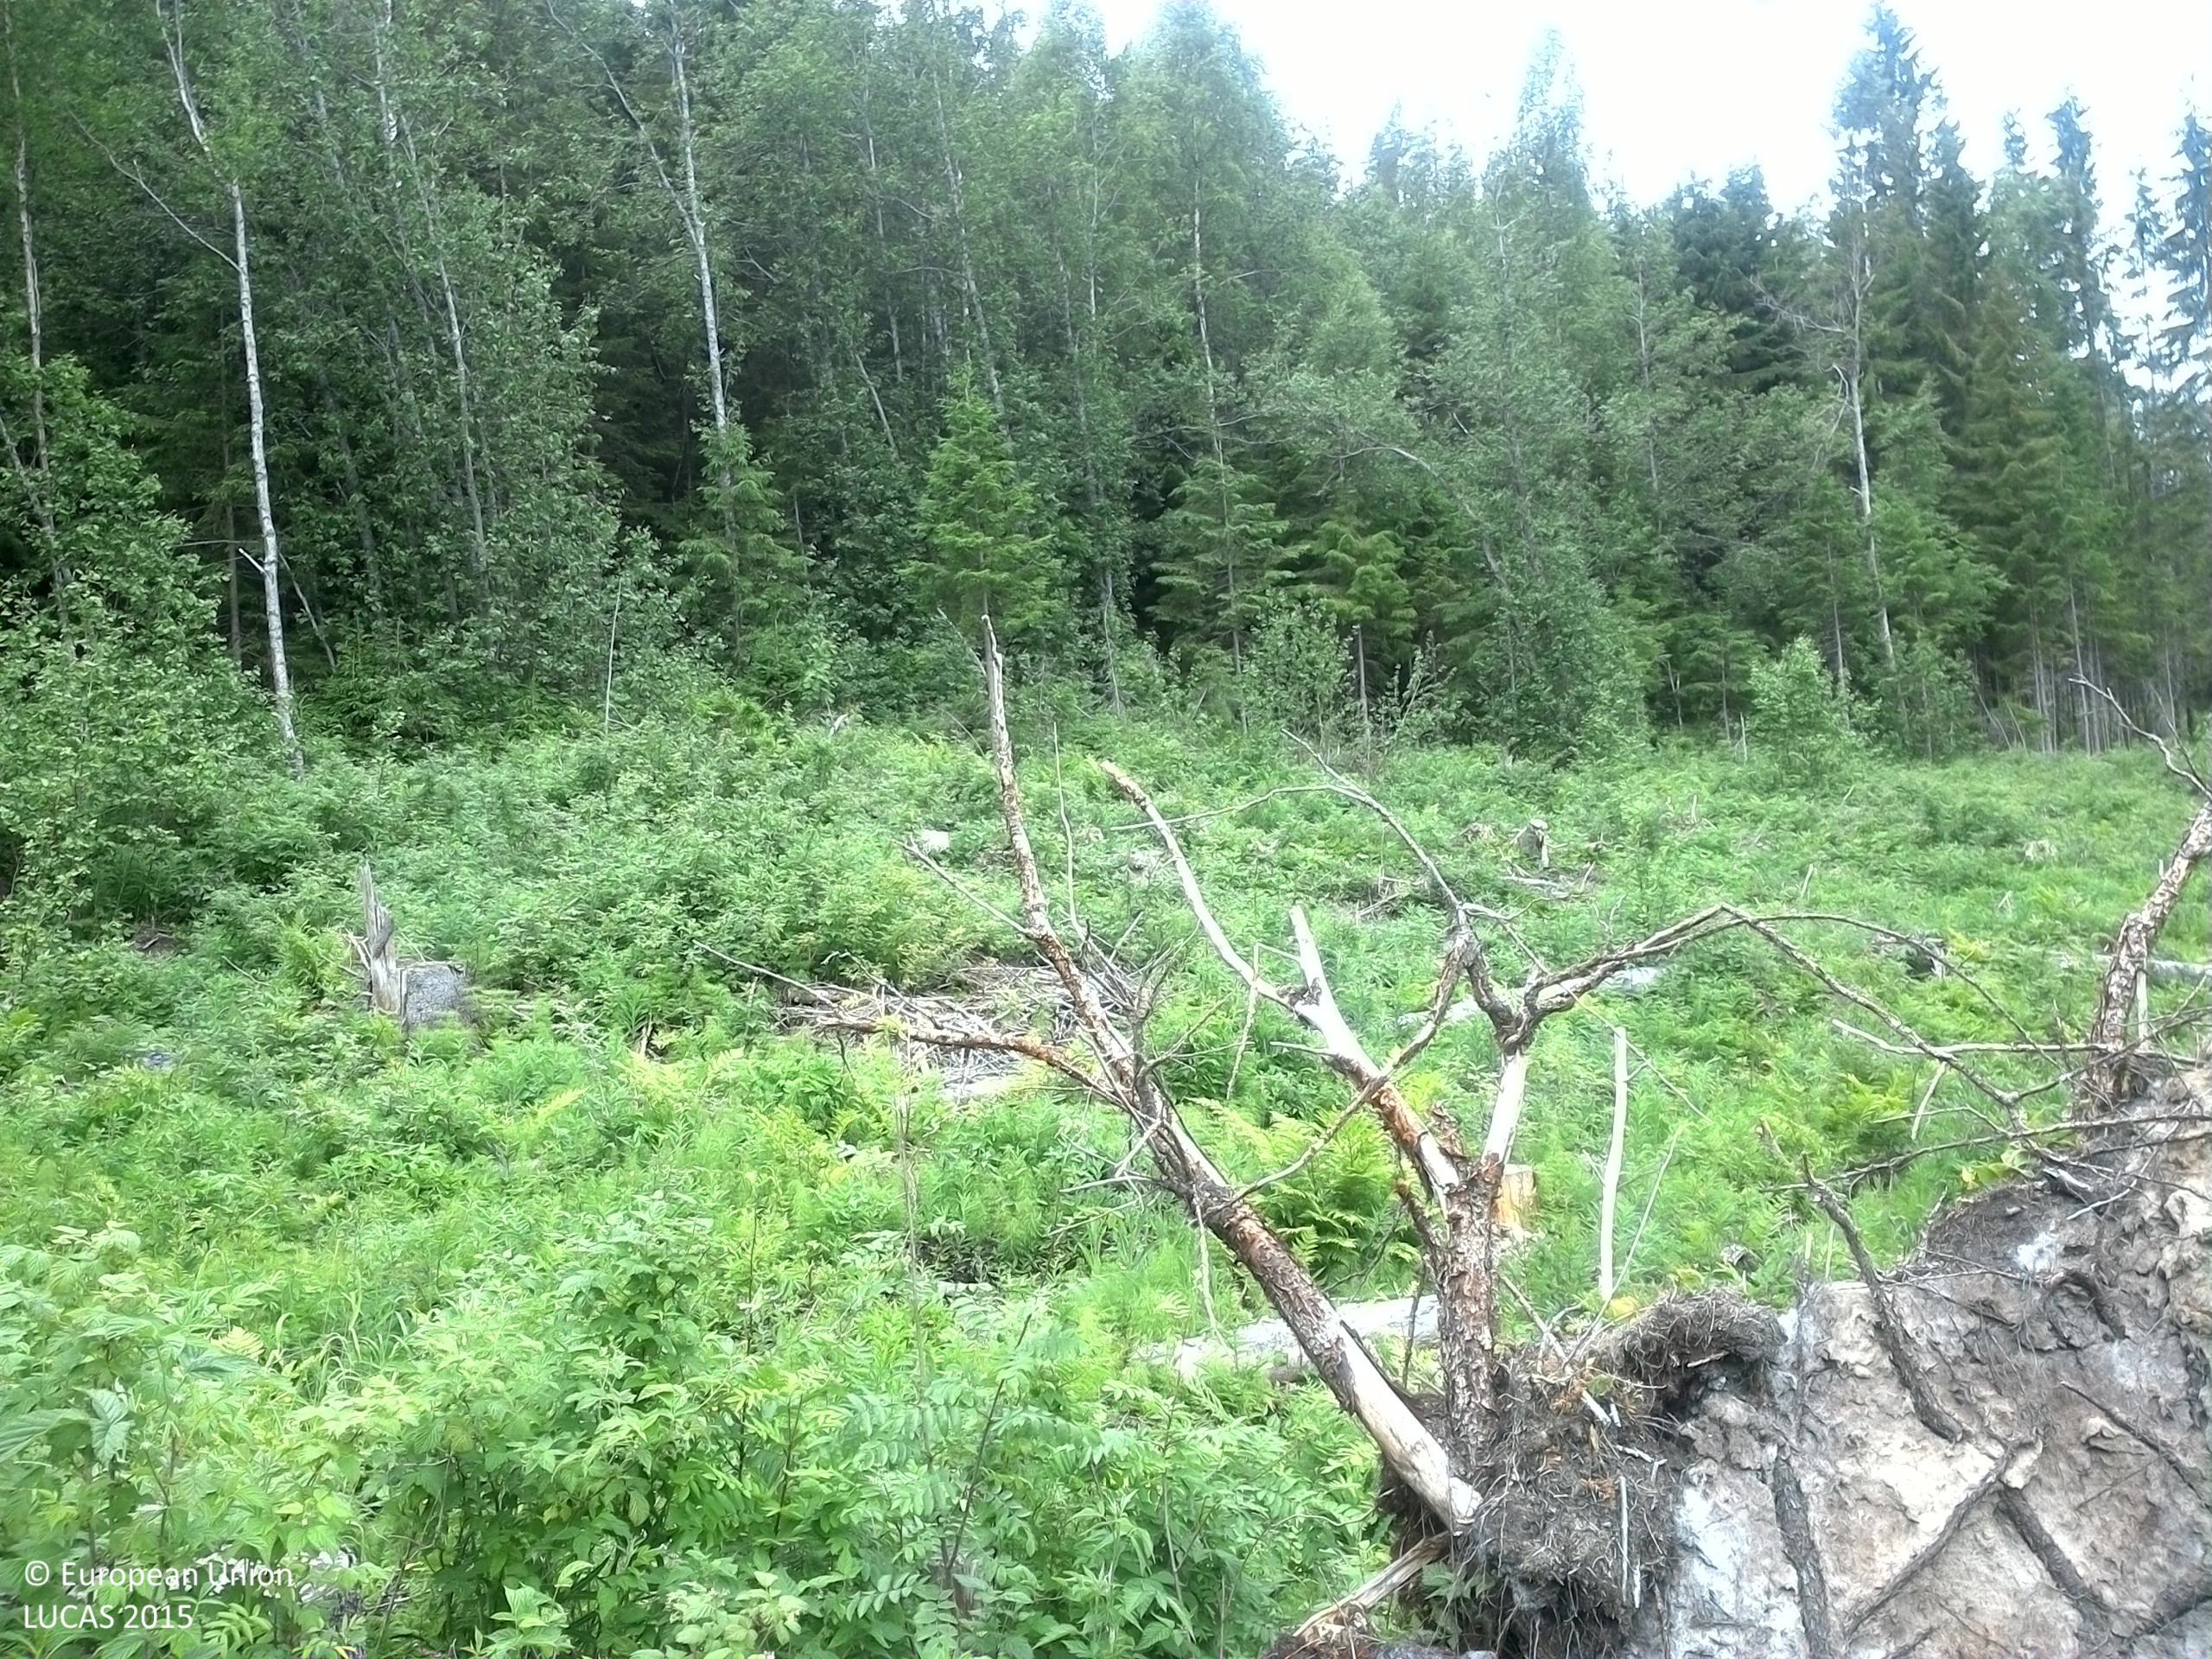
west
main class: Woodland
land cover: Broadleaved woodland
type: boreal forest
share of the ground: 10 - 25 %
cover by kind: shrubs 40 %, broadleaved forest trees 25 %, herbaceous plants 25 %, unconsolidated bare surface 10 %
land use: Forestry
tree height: < 5 m
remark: Clear cut
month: July
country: SE
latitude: 62.6555
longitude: 17.6095
